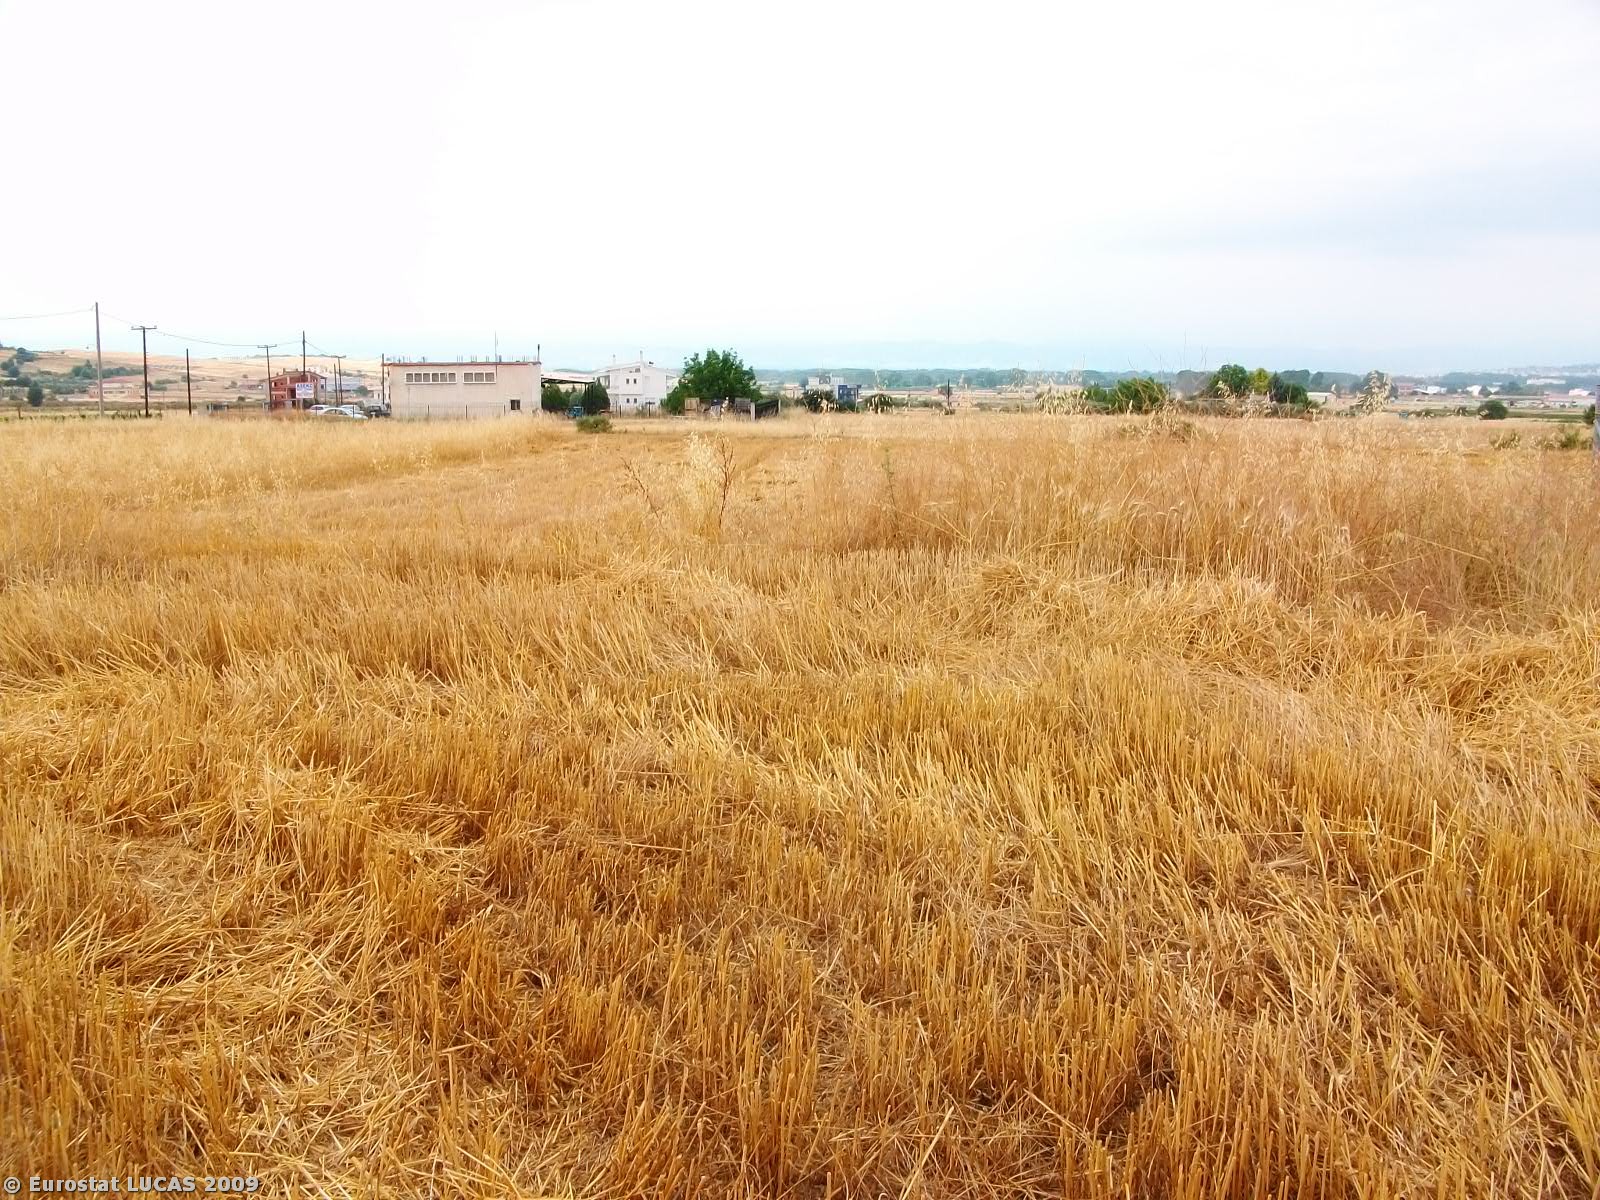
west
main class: Cropland
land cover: Durum wheat
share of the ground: > 75 %
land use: Agriculture (excluding fallow land and kitchen gardens)
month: June
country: GR
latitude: 41.0878
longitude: 23.6277
